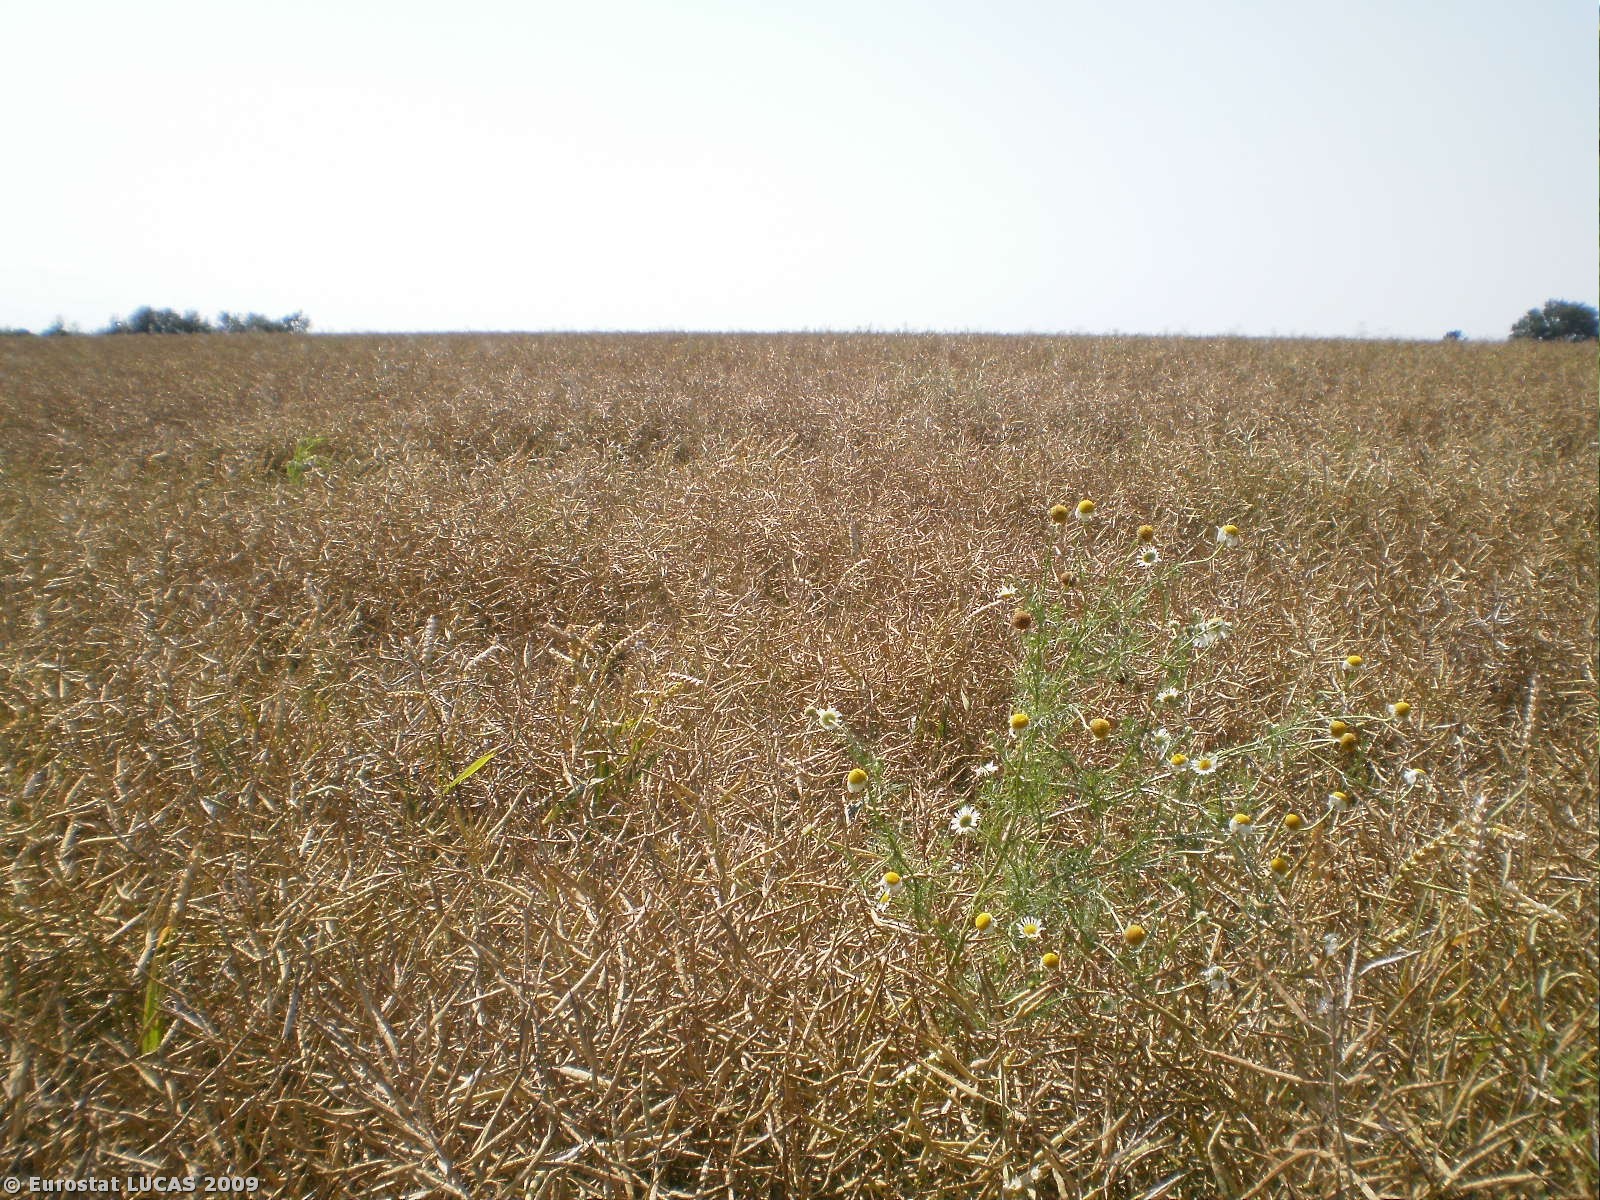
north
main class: Cropland
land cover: Rape and turnip rape
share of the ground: > 75 %
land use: Agriculture (excluding fallow land and kitchen gardens)
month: July
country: PL
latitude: 54.2296
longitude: 19.6454
